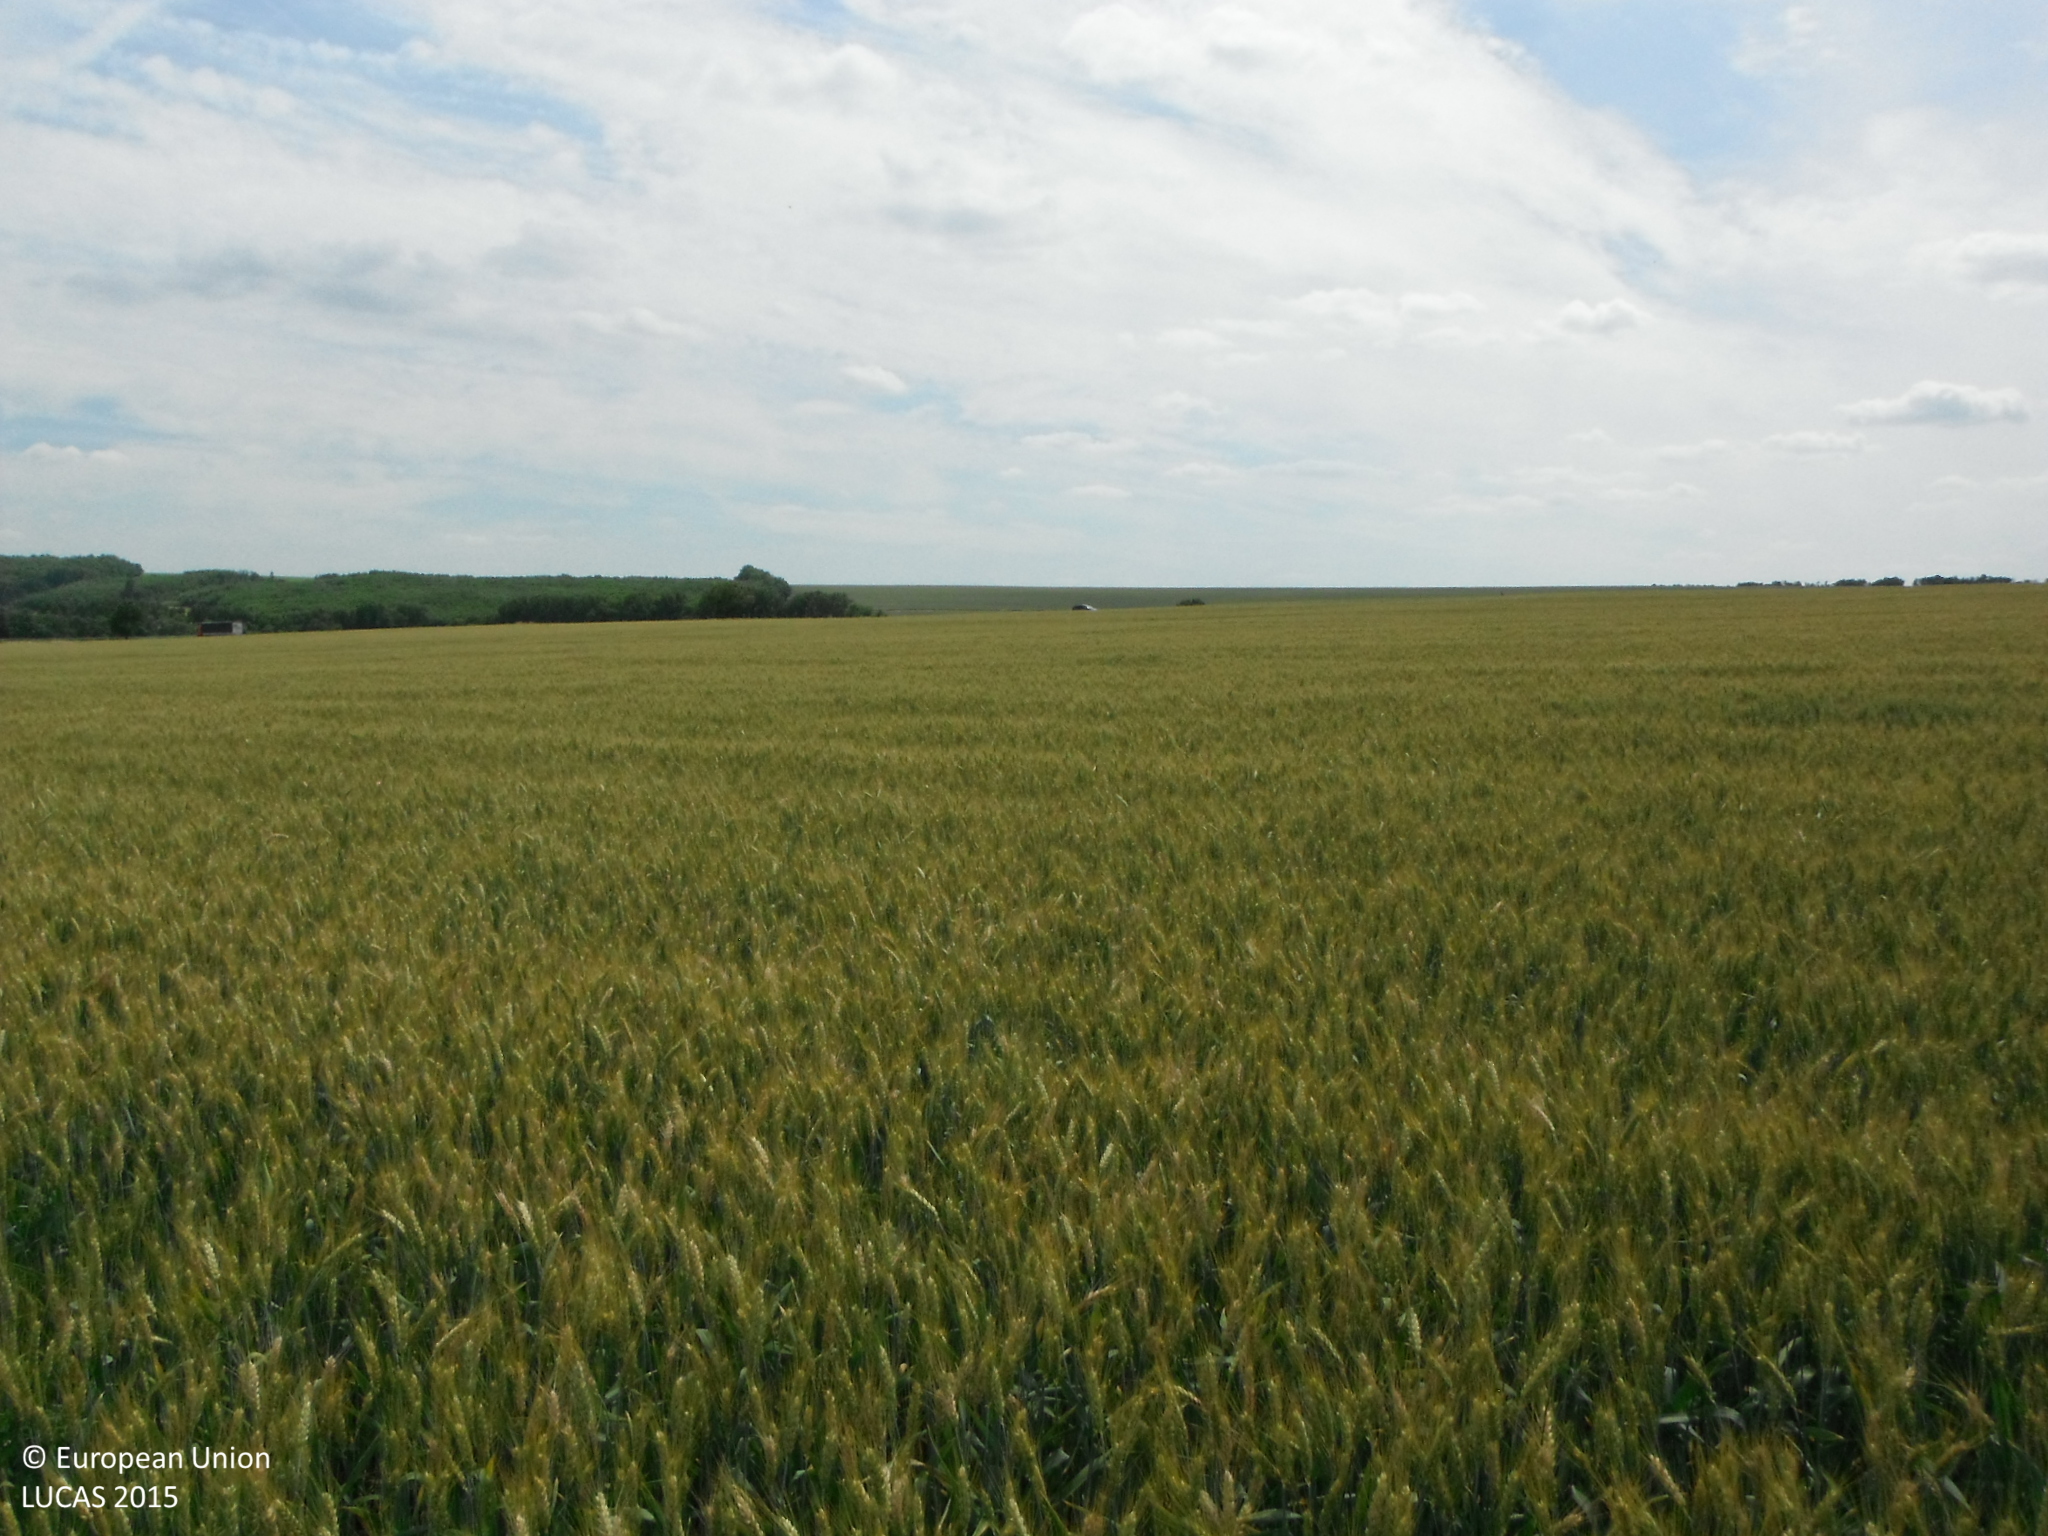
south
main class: Cropland
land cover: Common wheat
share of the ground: > 75 %
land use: Agriculture (excluding fallow land and kitchen gardens)
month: June
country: SK
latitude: 48.2759
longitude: 18.2475
